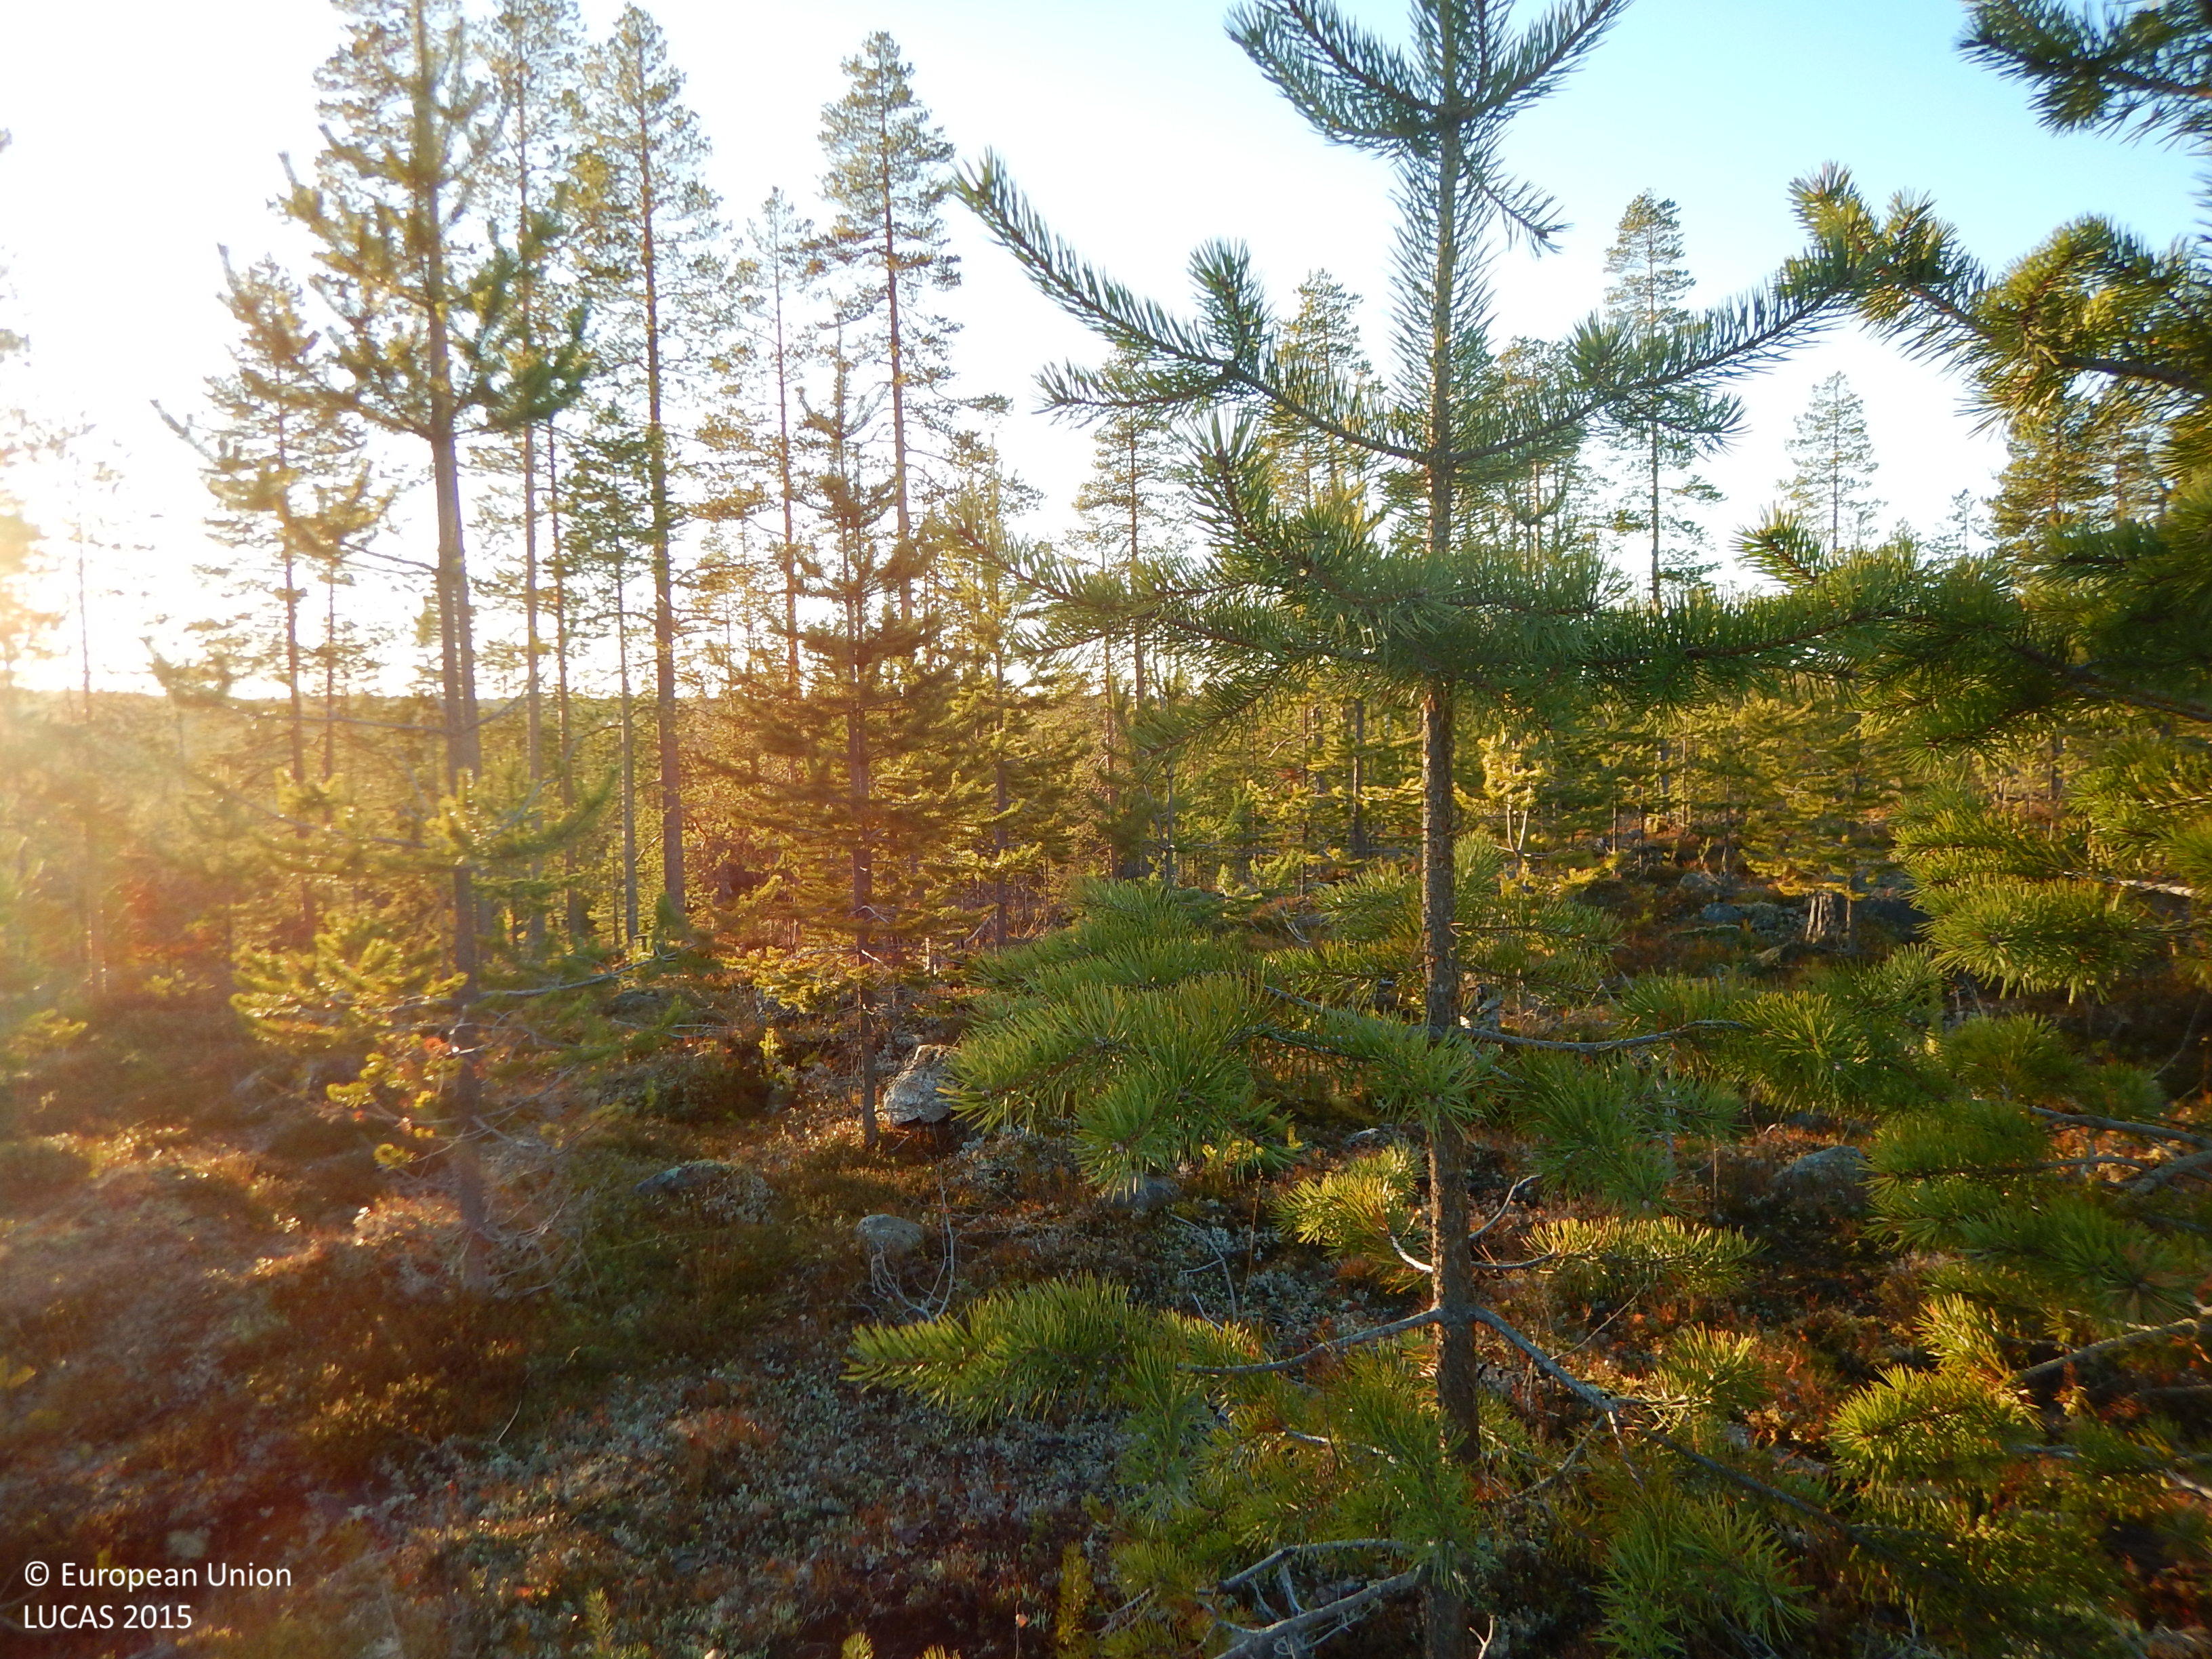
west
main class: Woodland
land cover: Pine dominated coniferous woodland
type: boreal forest
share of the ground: 50 - 75 %
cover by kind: coniferous forest trees 50 %, shrubs 25 %, lichens and mosses 20 %, broadleaved forest trees 5 %
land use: Forestry
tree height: < 5 m
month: November
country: SE
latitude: 65.3718
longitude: 20.6578
